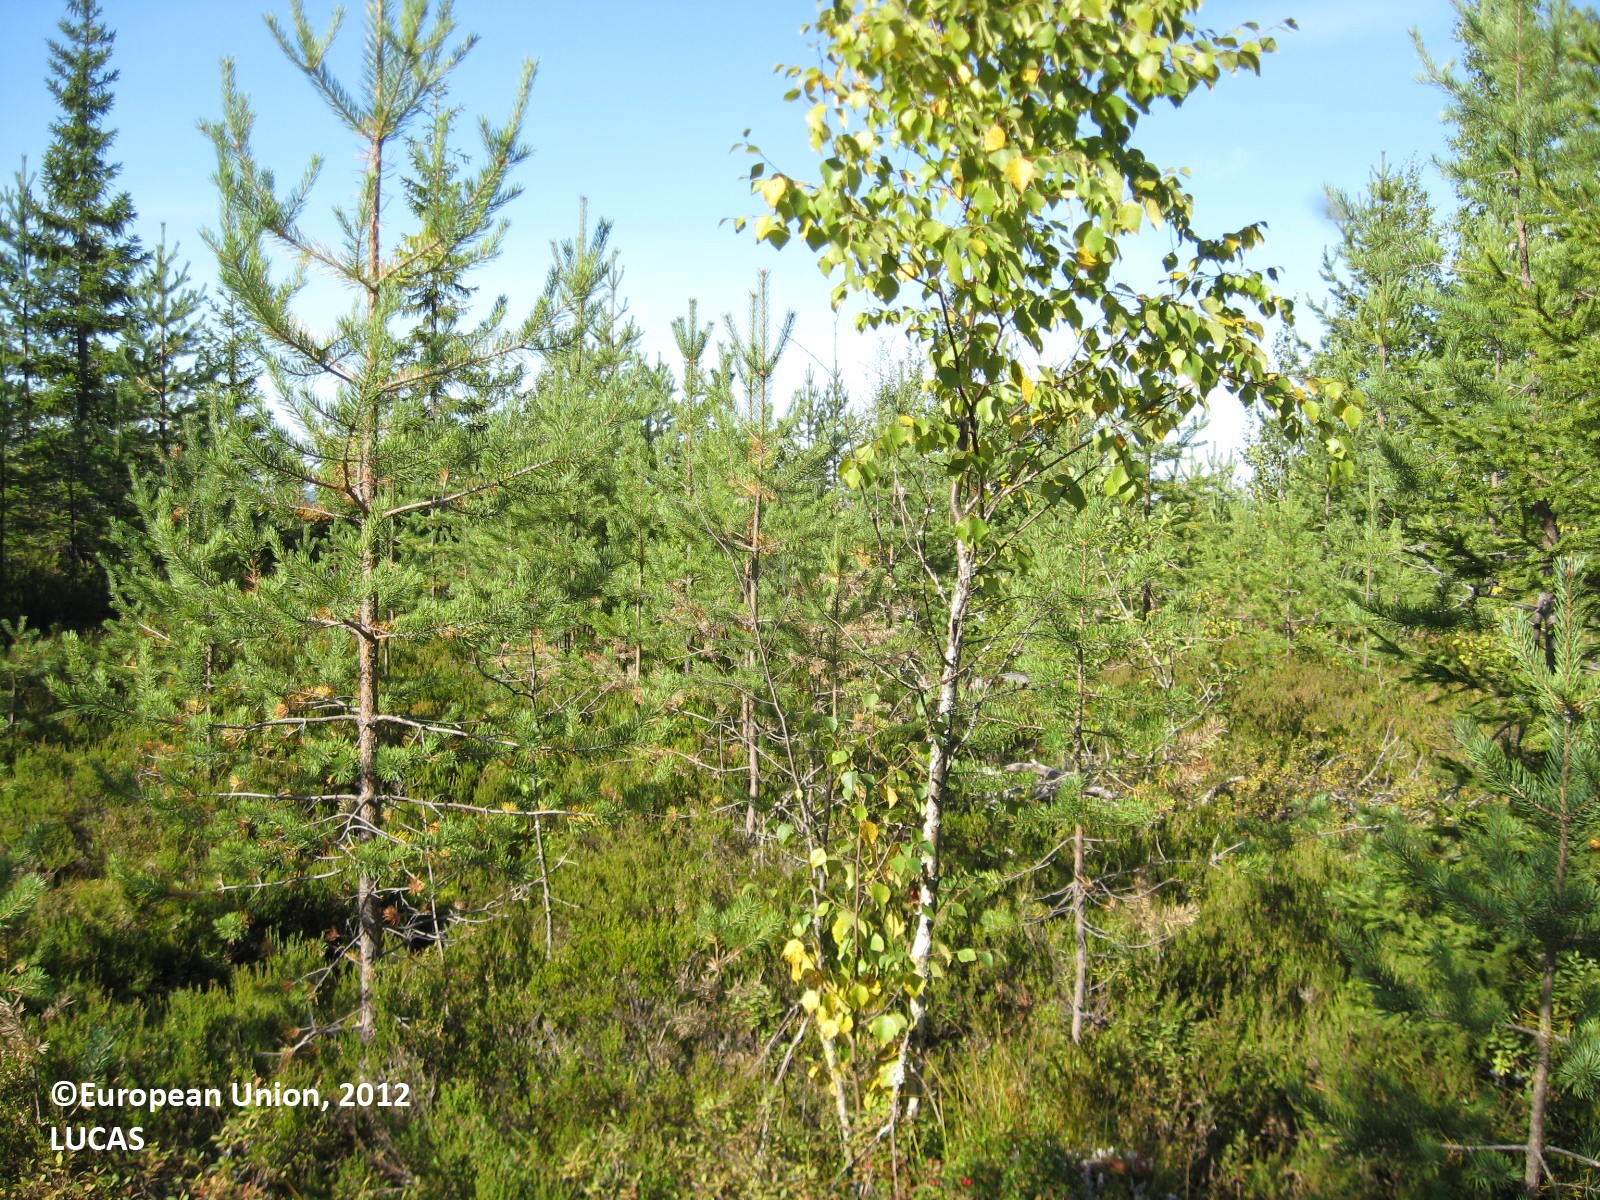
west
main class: Woodland
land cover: Other mixed woodland
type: boreal forest
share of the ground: 50 - 75 %
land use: Forestry
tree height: < 5 m
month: August
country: FI
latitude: 63.7689
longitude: 29.3400
